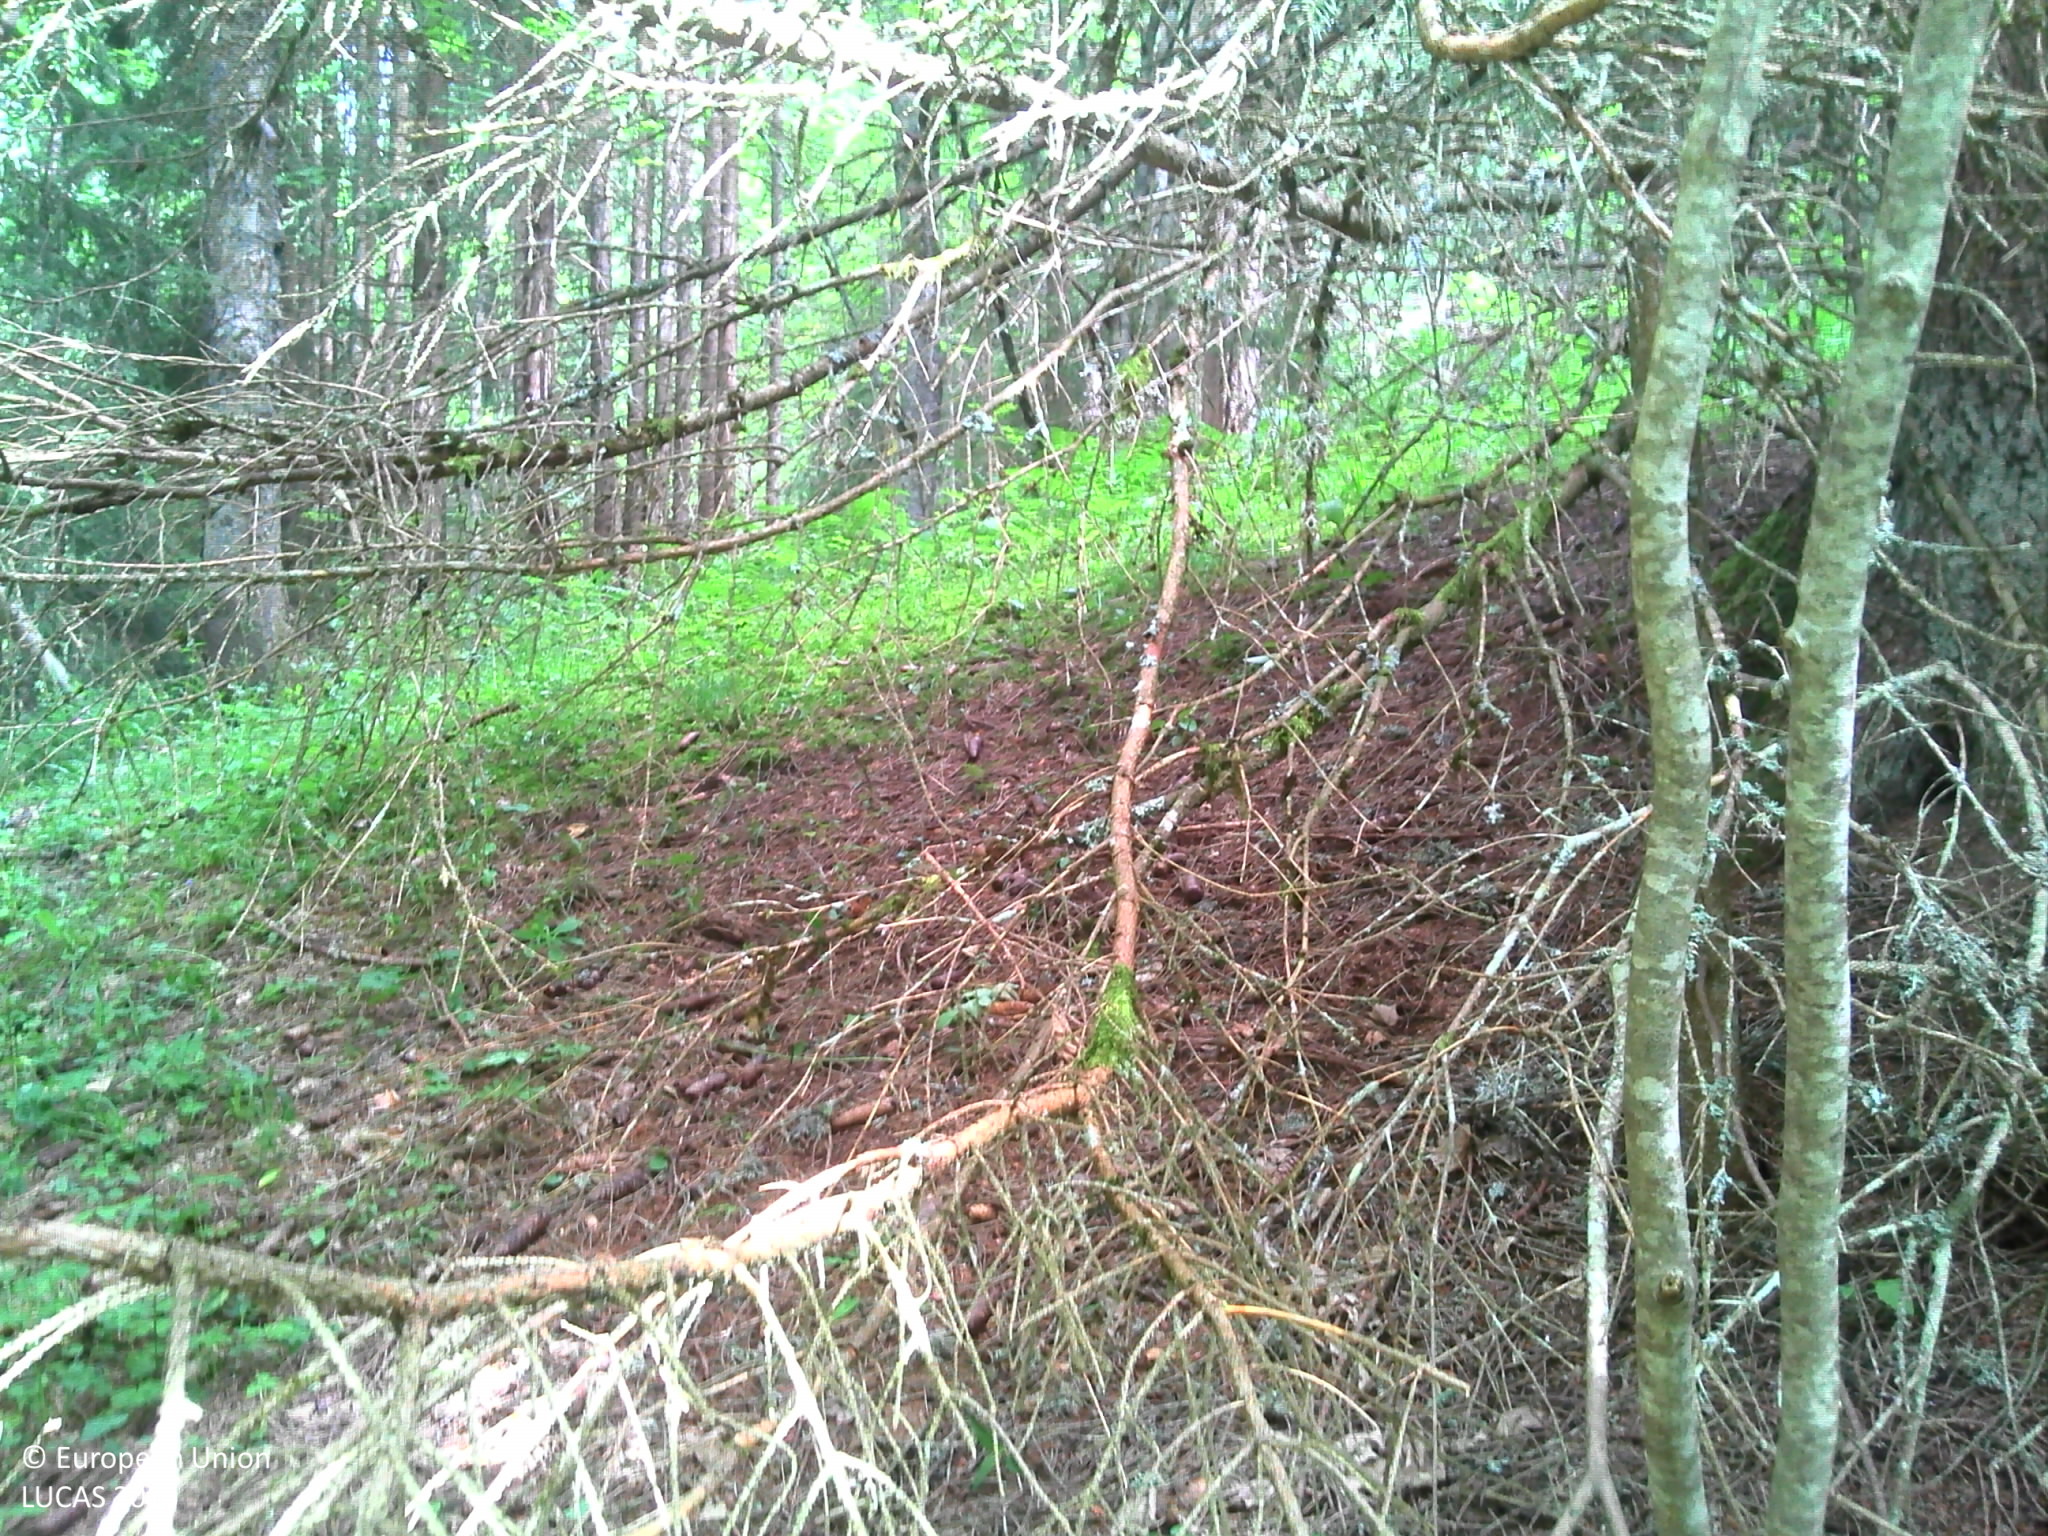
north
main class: Woodland
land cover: Spruce dominated coniferous woodland
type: alpine coniferous forest
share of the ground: > 75 %
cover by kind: coniferous forest trees 70 %, herbaceous plants 15 %, broadleaved forest trees 10 %, lichens and mosses 5 %
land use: Forestry
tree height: > 5 m
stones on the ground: < 10 %
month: July
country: FR
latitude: 45.9499
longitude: 6.4561
